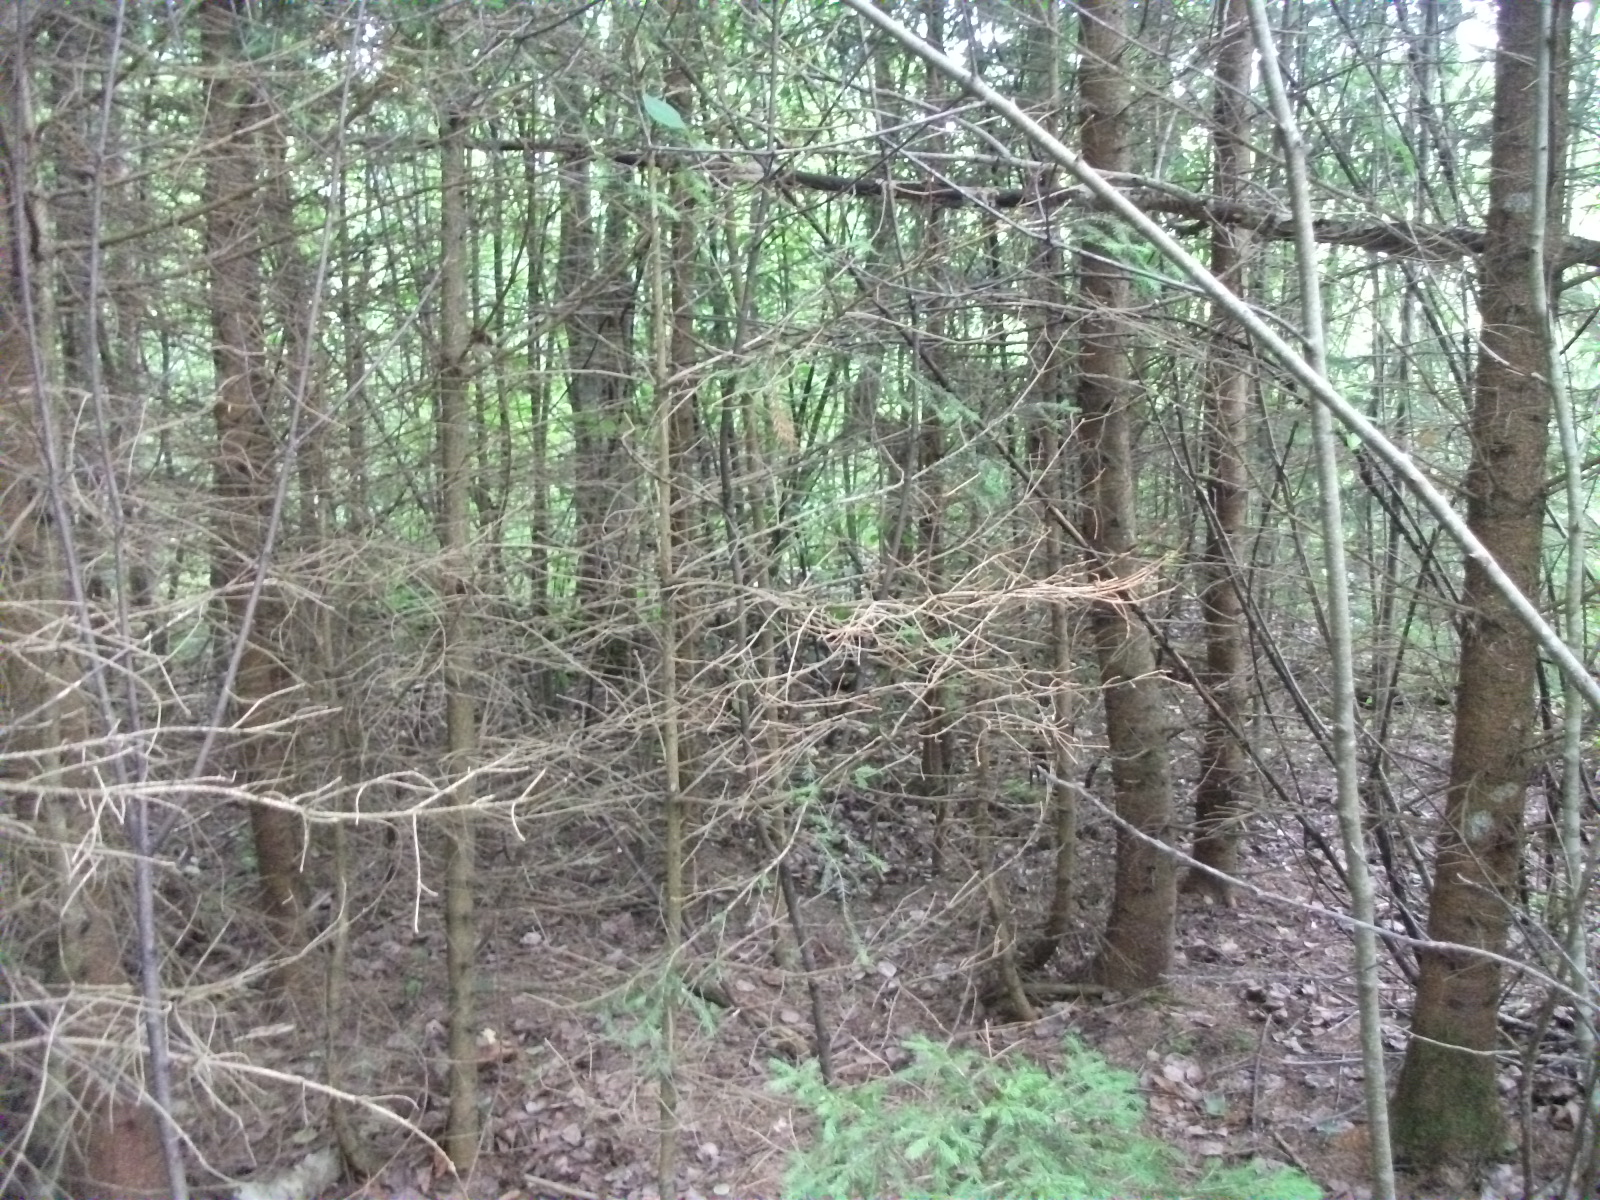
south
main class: Woodland
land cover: Spruce dominated coniferous woodland
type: hemiboreal forest and nemoral coniferous forest and mixed broadleaved-coniferous forest
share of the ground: > 75 %
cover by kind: coniferous forest trees 90 %, herbaceous plants 5 %, unconsolidated bare surface 5 %
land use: Forestry
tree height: > 5 m
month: July
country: LV
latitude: 57.1833
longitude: 26.5408
